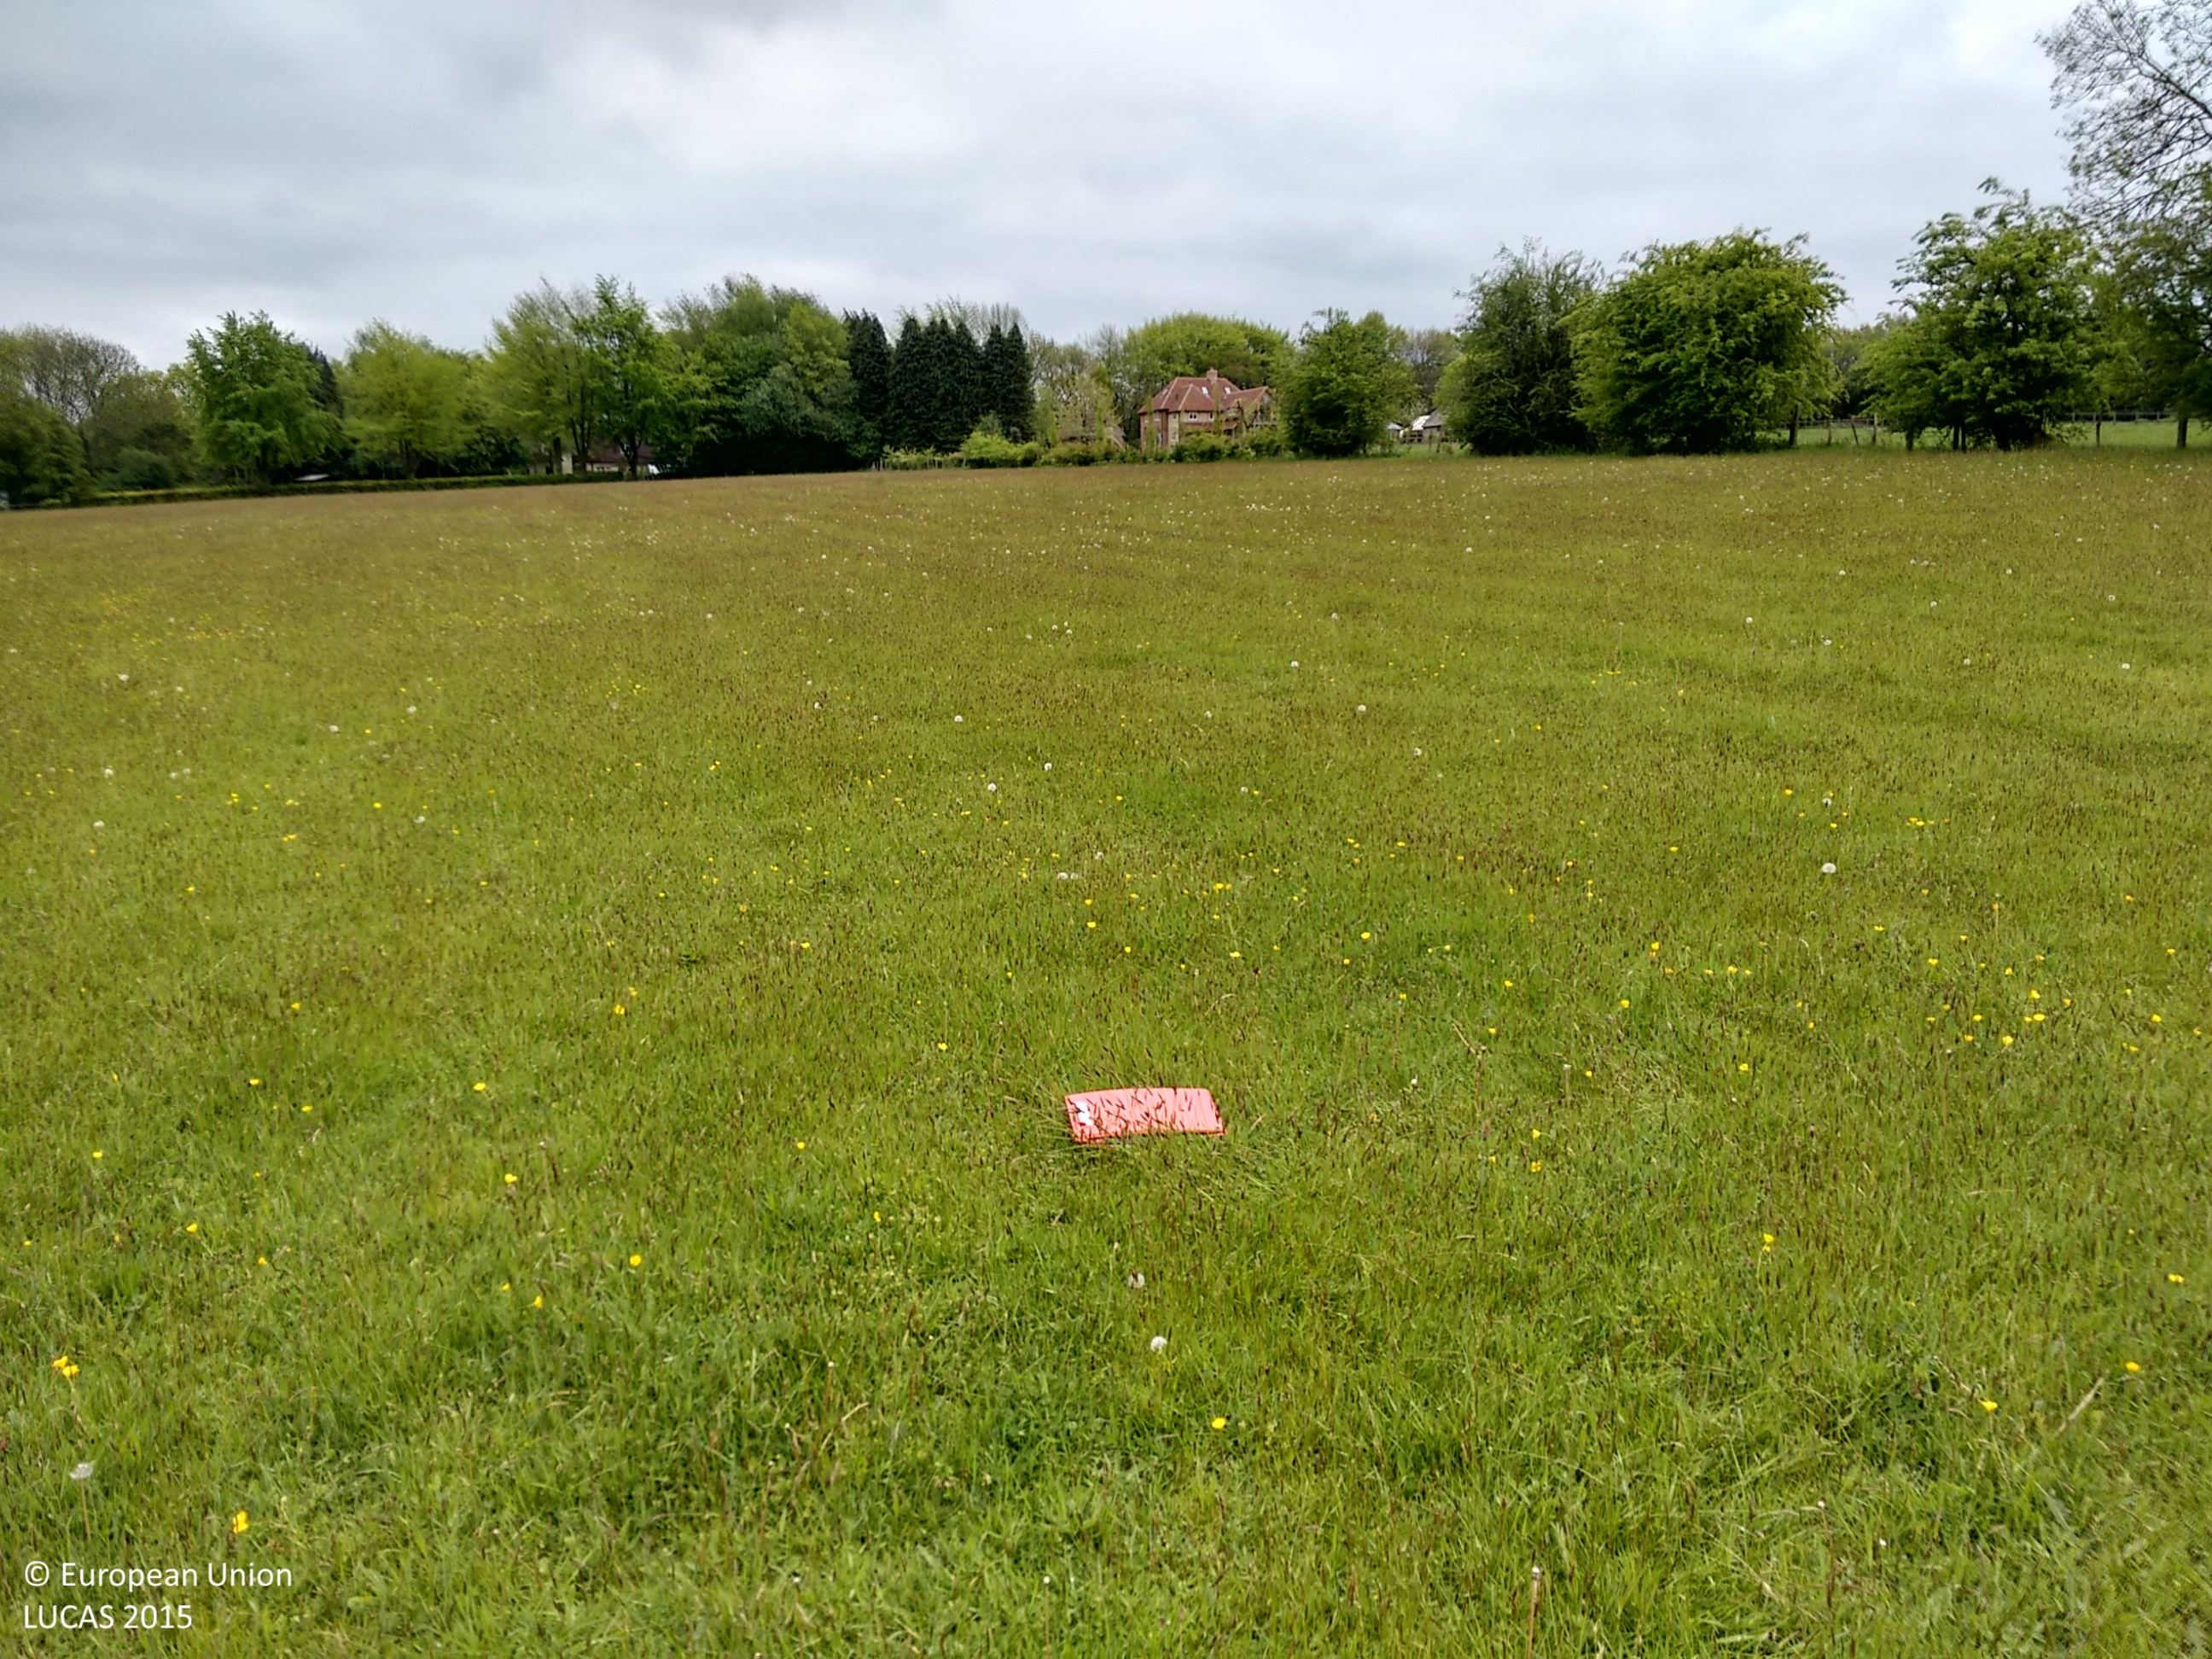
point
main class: Grassland
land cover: Grassland without tree/shrub cover
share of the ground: > 75 %
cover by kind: herbaceous plants 100 %
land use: Agriculture (excluding fallow land and kitchen gardens)
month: May
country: GB
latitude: 51.0315
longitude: -0.9811
